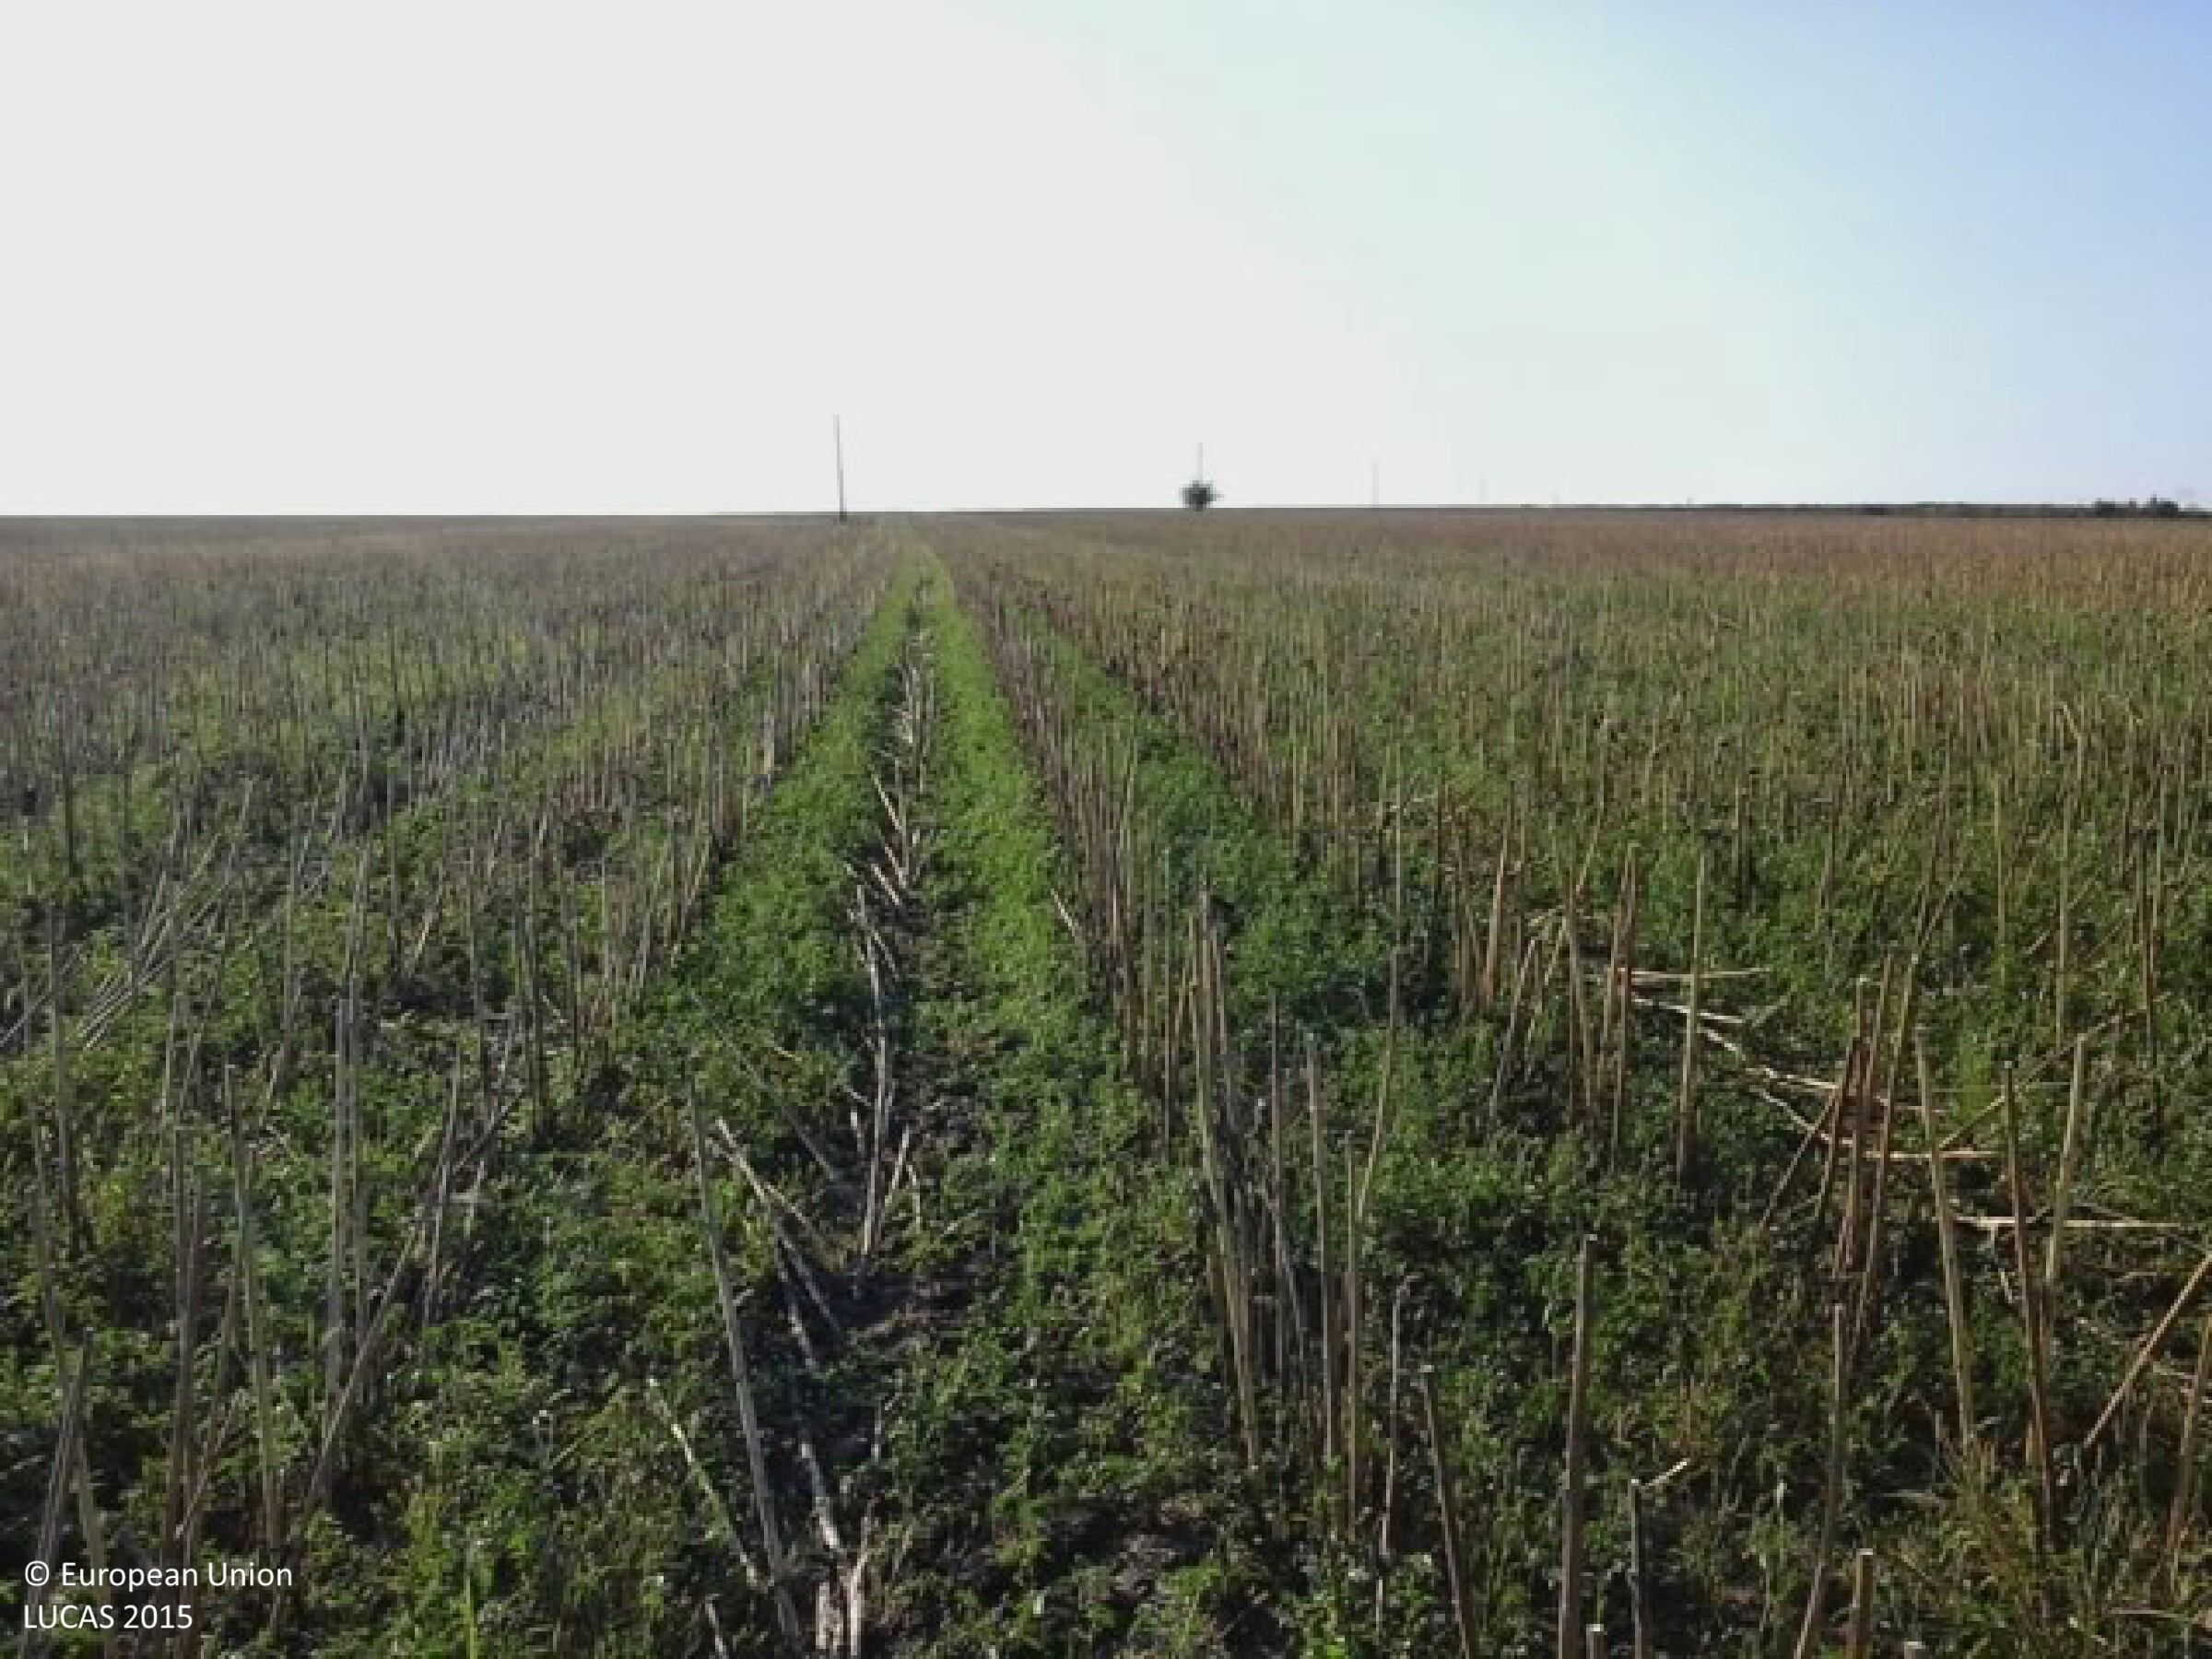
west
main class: Cropland
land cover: Sunflower
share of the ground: < 10 %
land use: Agriculture (excluding fallow land and kitchen gardens)
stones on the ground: < 10 %
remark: Harvested field
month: September
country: HU
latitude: 47.6889
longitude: 19.8712
